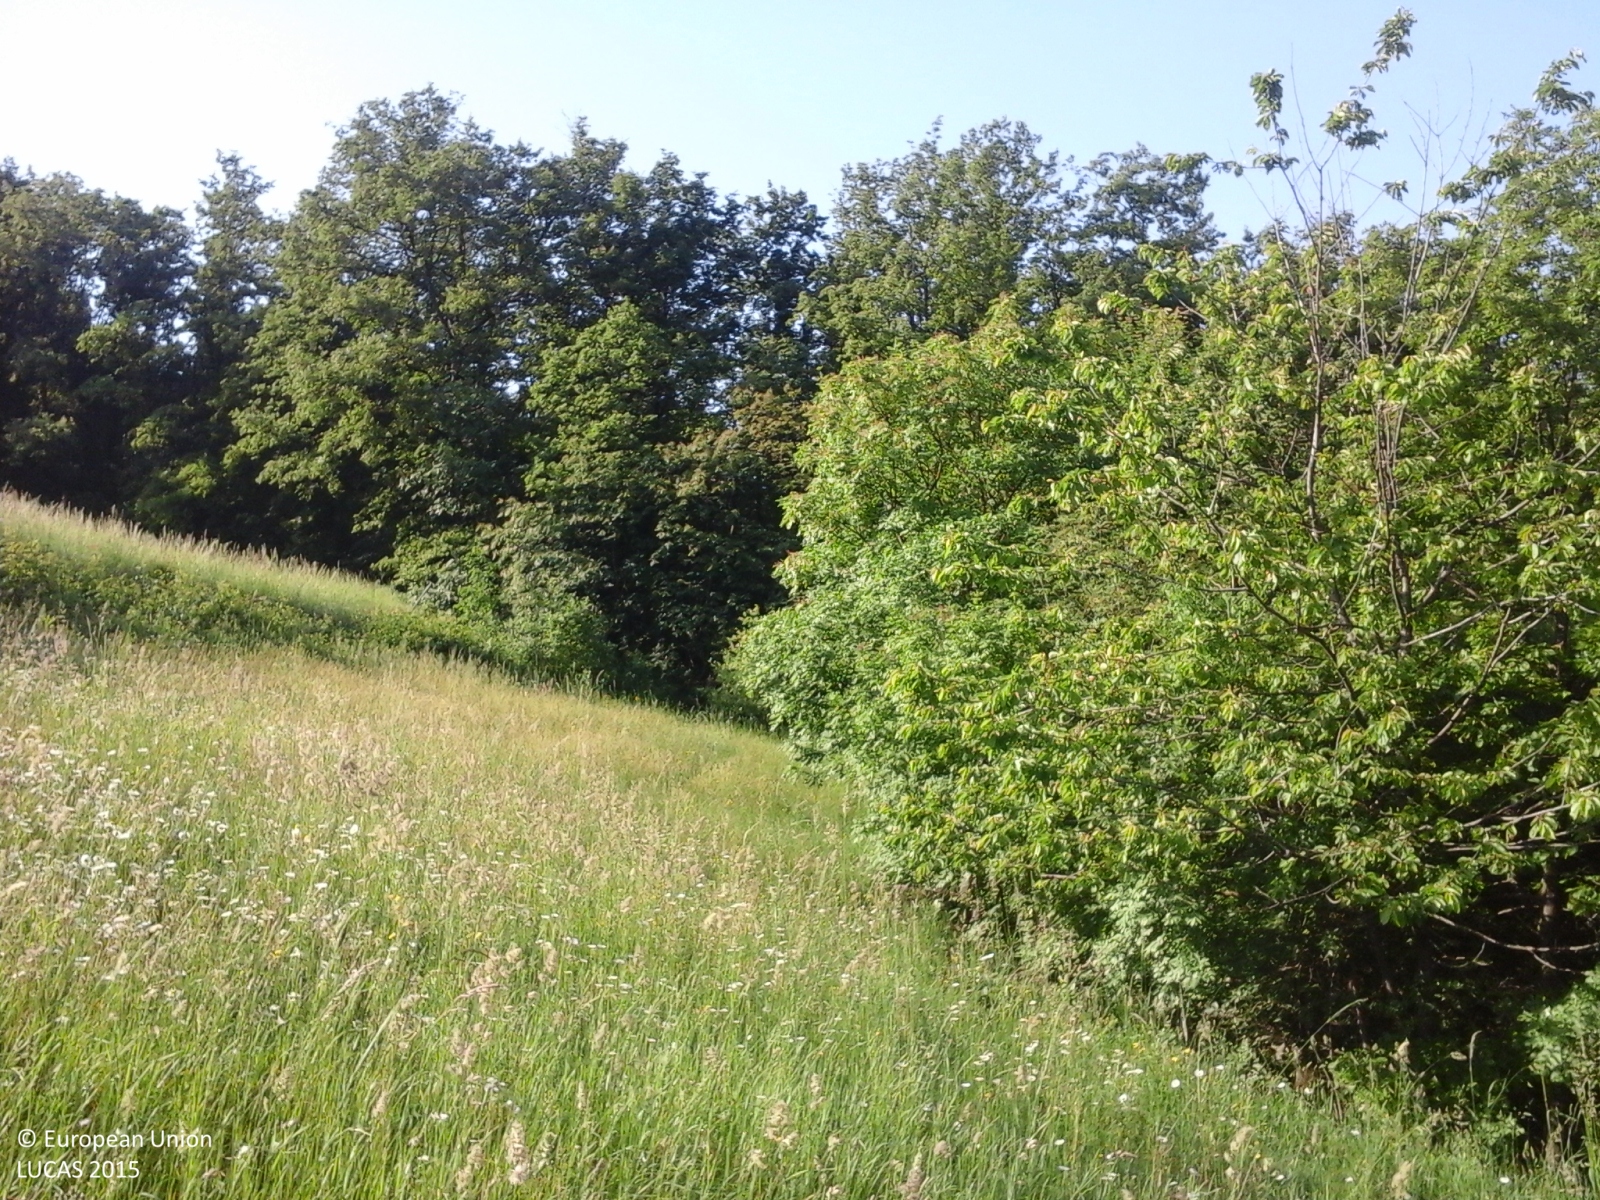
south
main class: Woodland
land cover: Broadleaved woodland
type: mesophytic deciduous forest
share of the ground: > 75 %
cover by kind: broadleaved forest trees 100 %
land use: Forestry
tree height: > 5 m
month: May
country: IT
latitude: 44.4371
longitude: 10.8649
